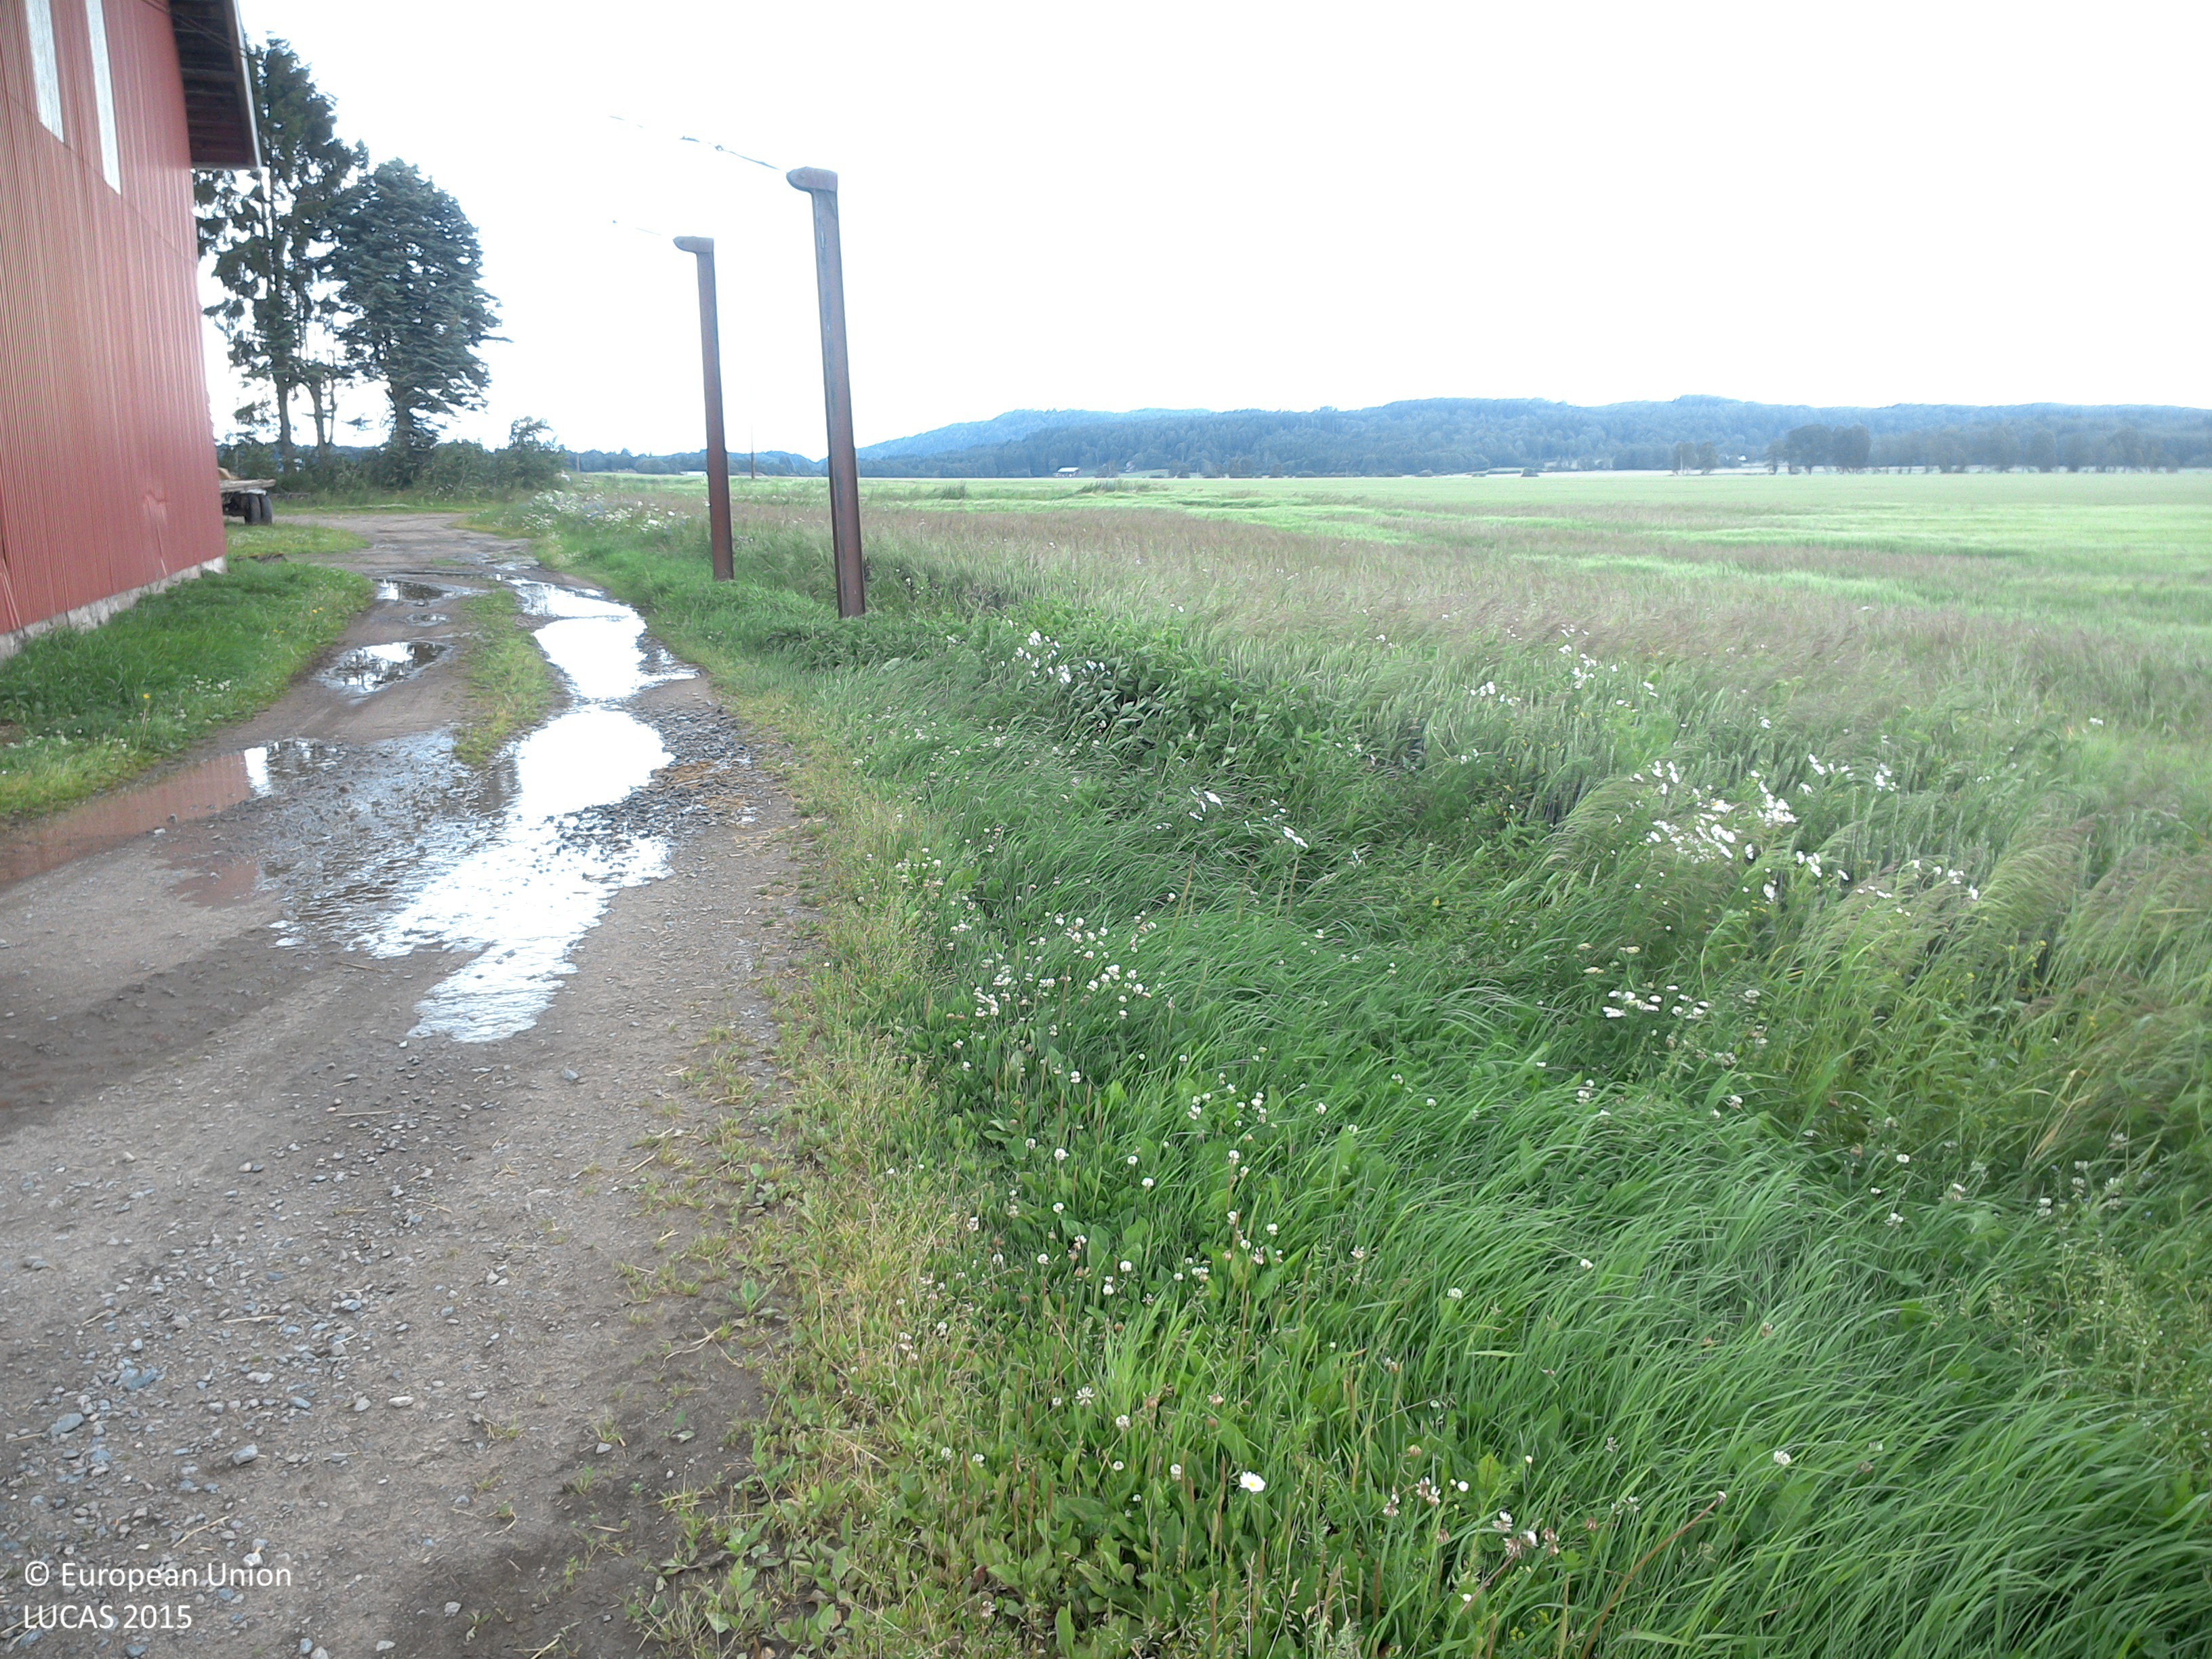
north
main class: Cropland
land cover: Rye
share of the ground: > 75 %
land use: Agriculture (excluding fallow land and kitchen gardens)
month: July
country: SE
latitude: 58.5773
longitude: 14.9978
